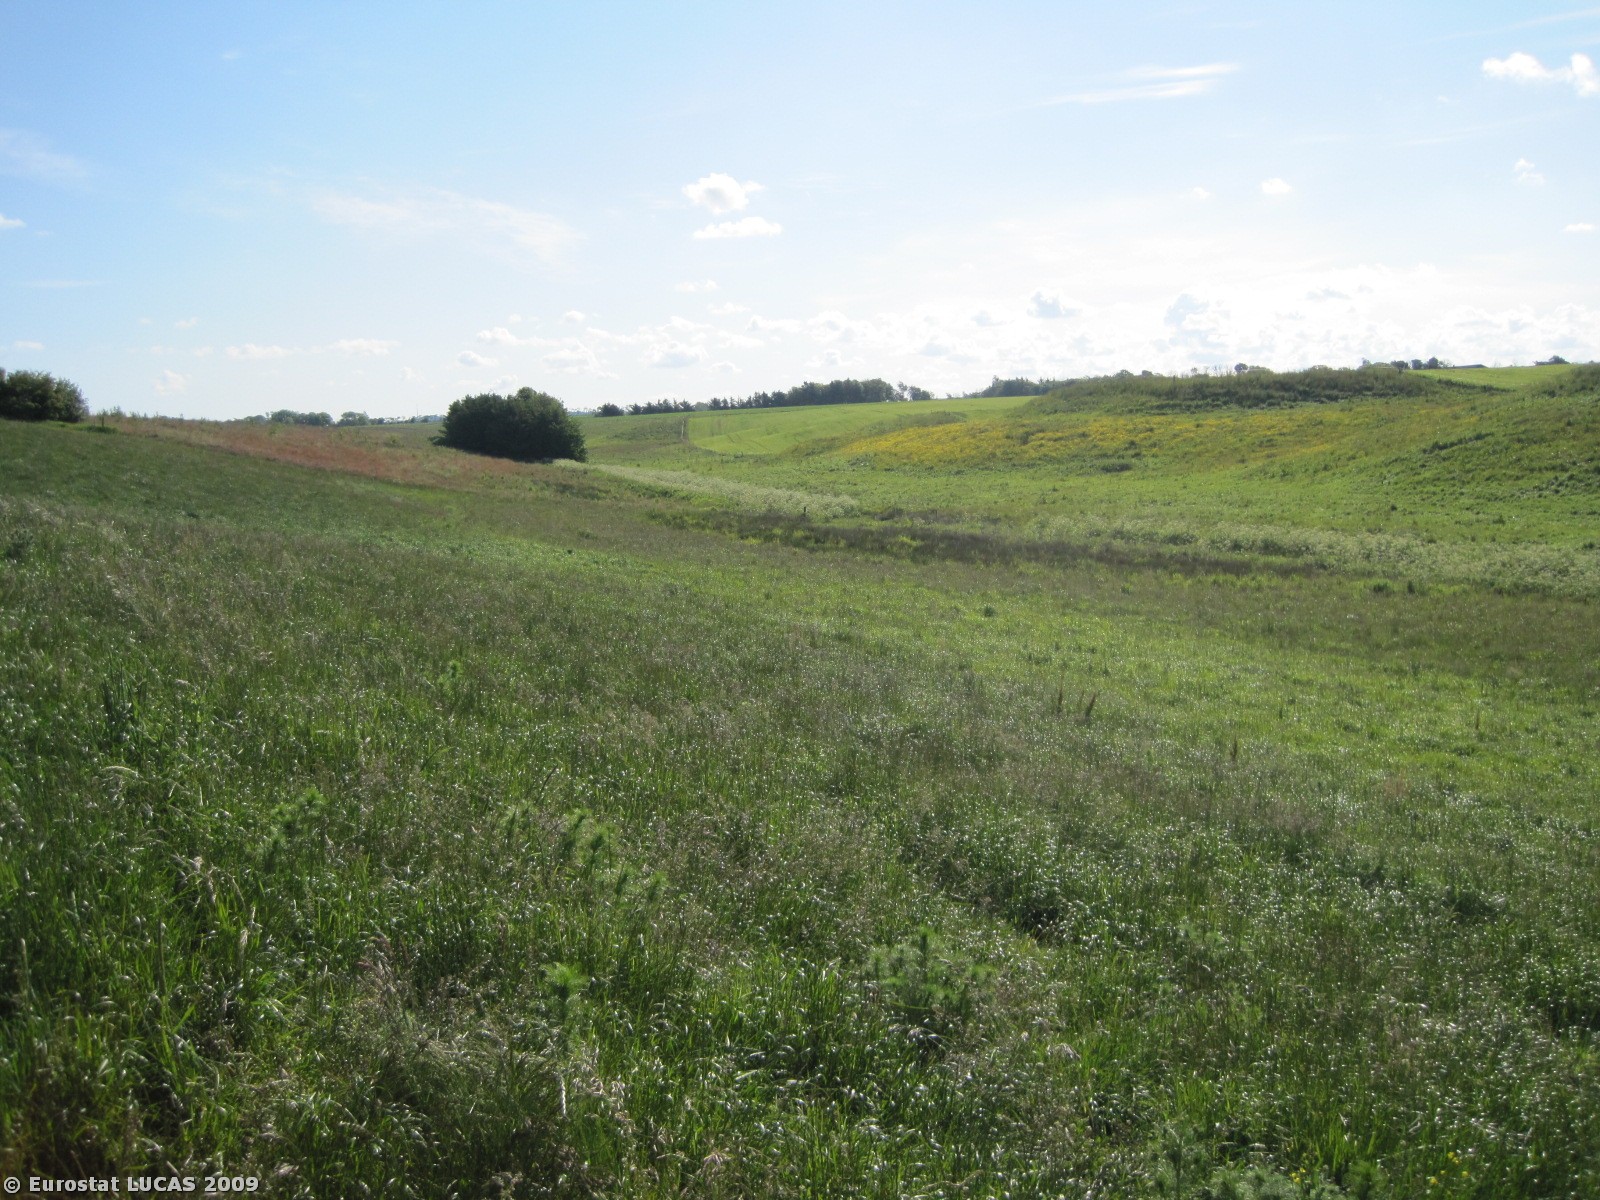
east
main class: Grassland
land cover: Grassland without tree/shrub cover
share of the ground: > 75 %
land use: Agriculture (excluding fallow land and kitchen gardens)
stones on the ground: < 10 %
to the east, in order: Grassland without tree/shrub cover; Fences; Grassland without tree/shrub cover; Ditches and canals; Grassland without tree/shrub cover; Fences; Grassland without tree/shrub cover; Fences; Arable land (only in case pi)
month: June
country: DK
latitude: 57.4461
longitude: 9.8836
